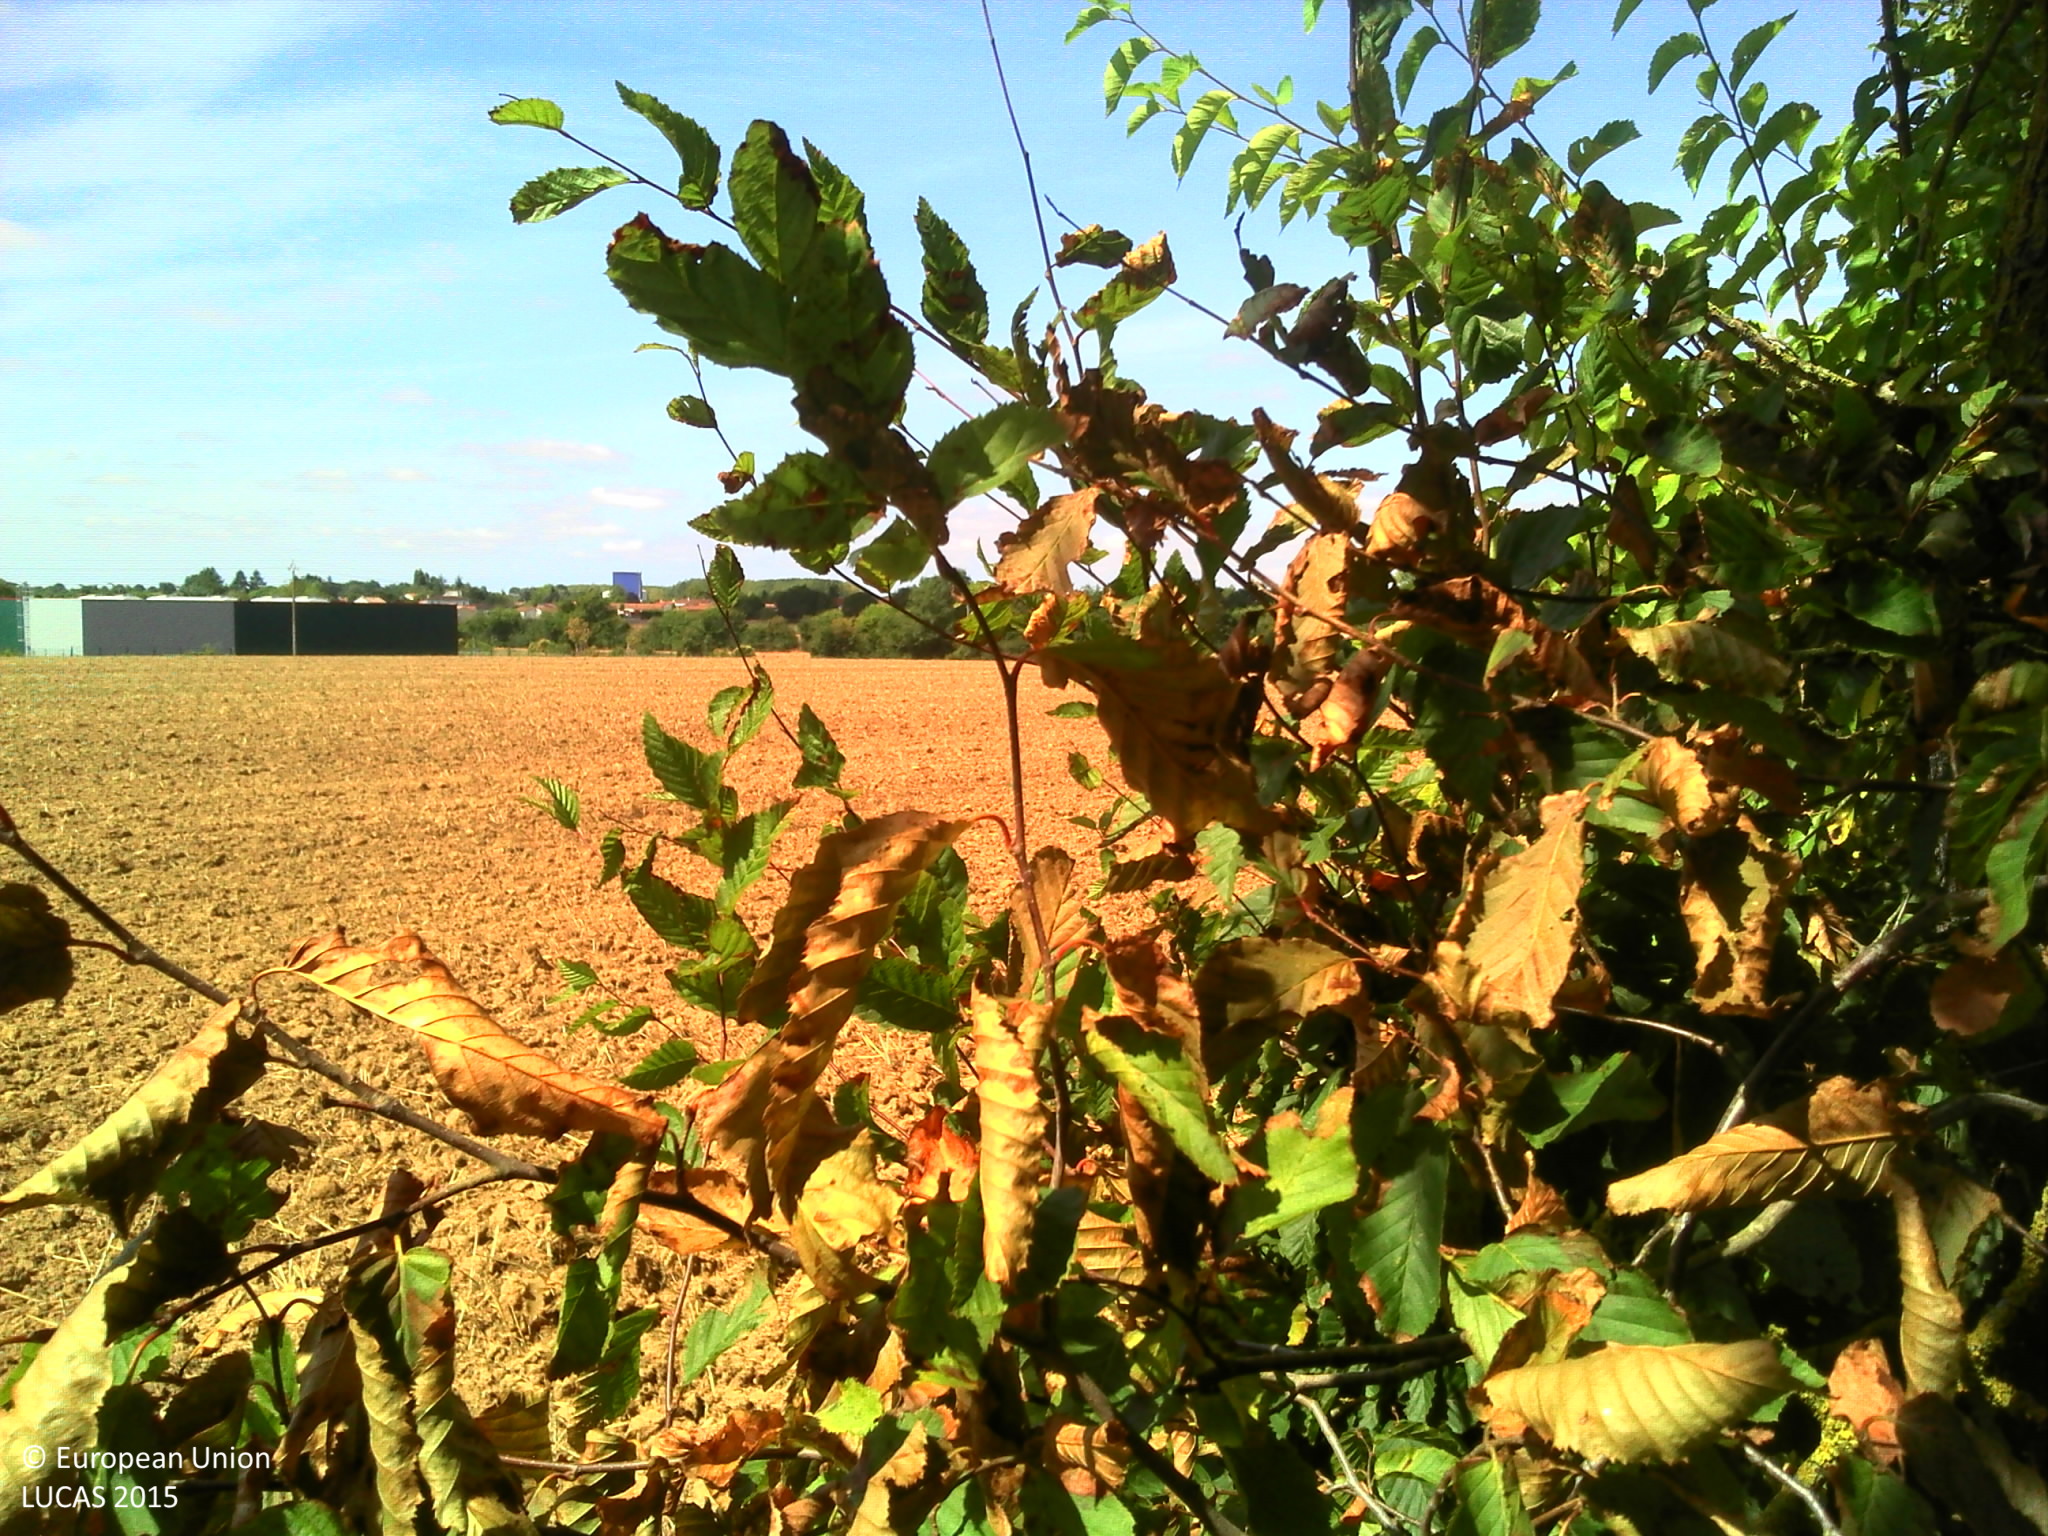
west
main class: Grassland
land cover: Grassland without tree/shrub cover
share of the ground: > 75 %
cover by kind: herbaceous plants 100 %
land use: Agriculture (excluding fallow land and kitchen gardens)
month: August
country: FR
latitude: 46.7274
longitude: -1.1702
